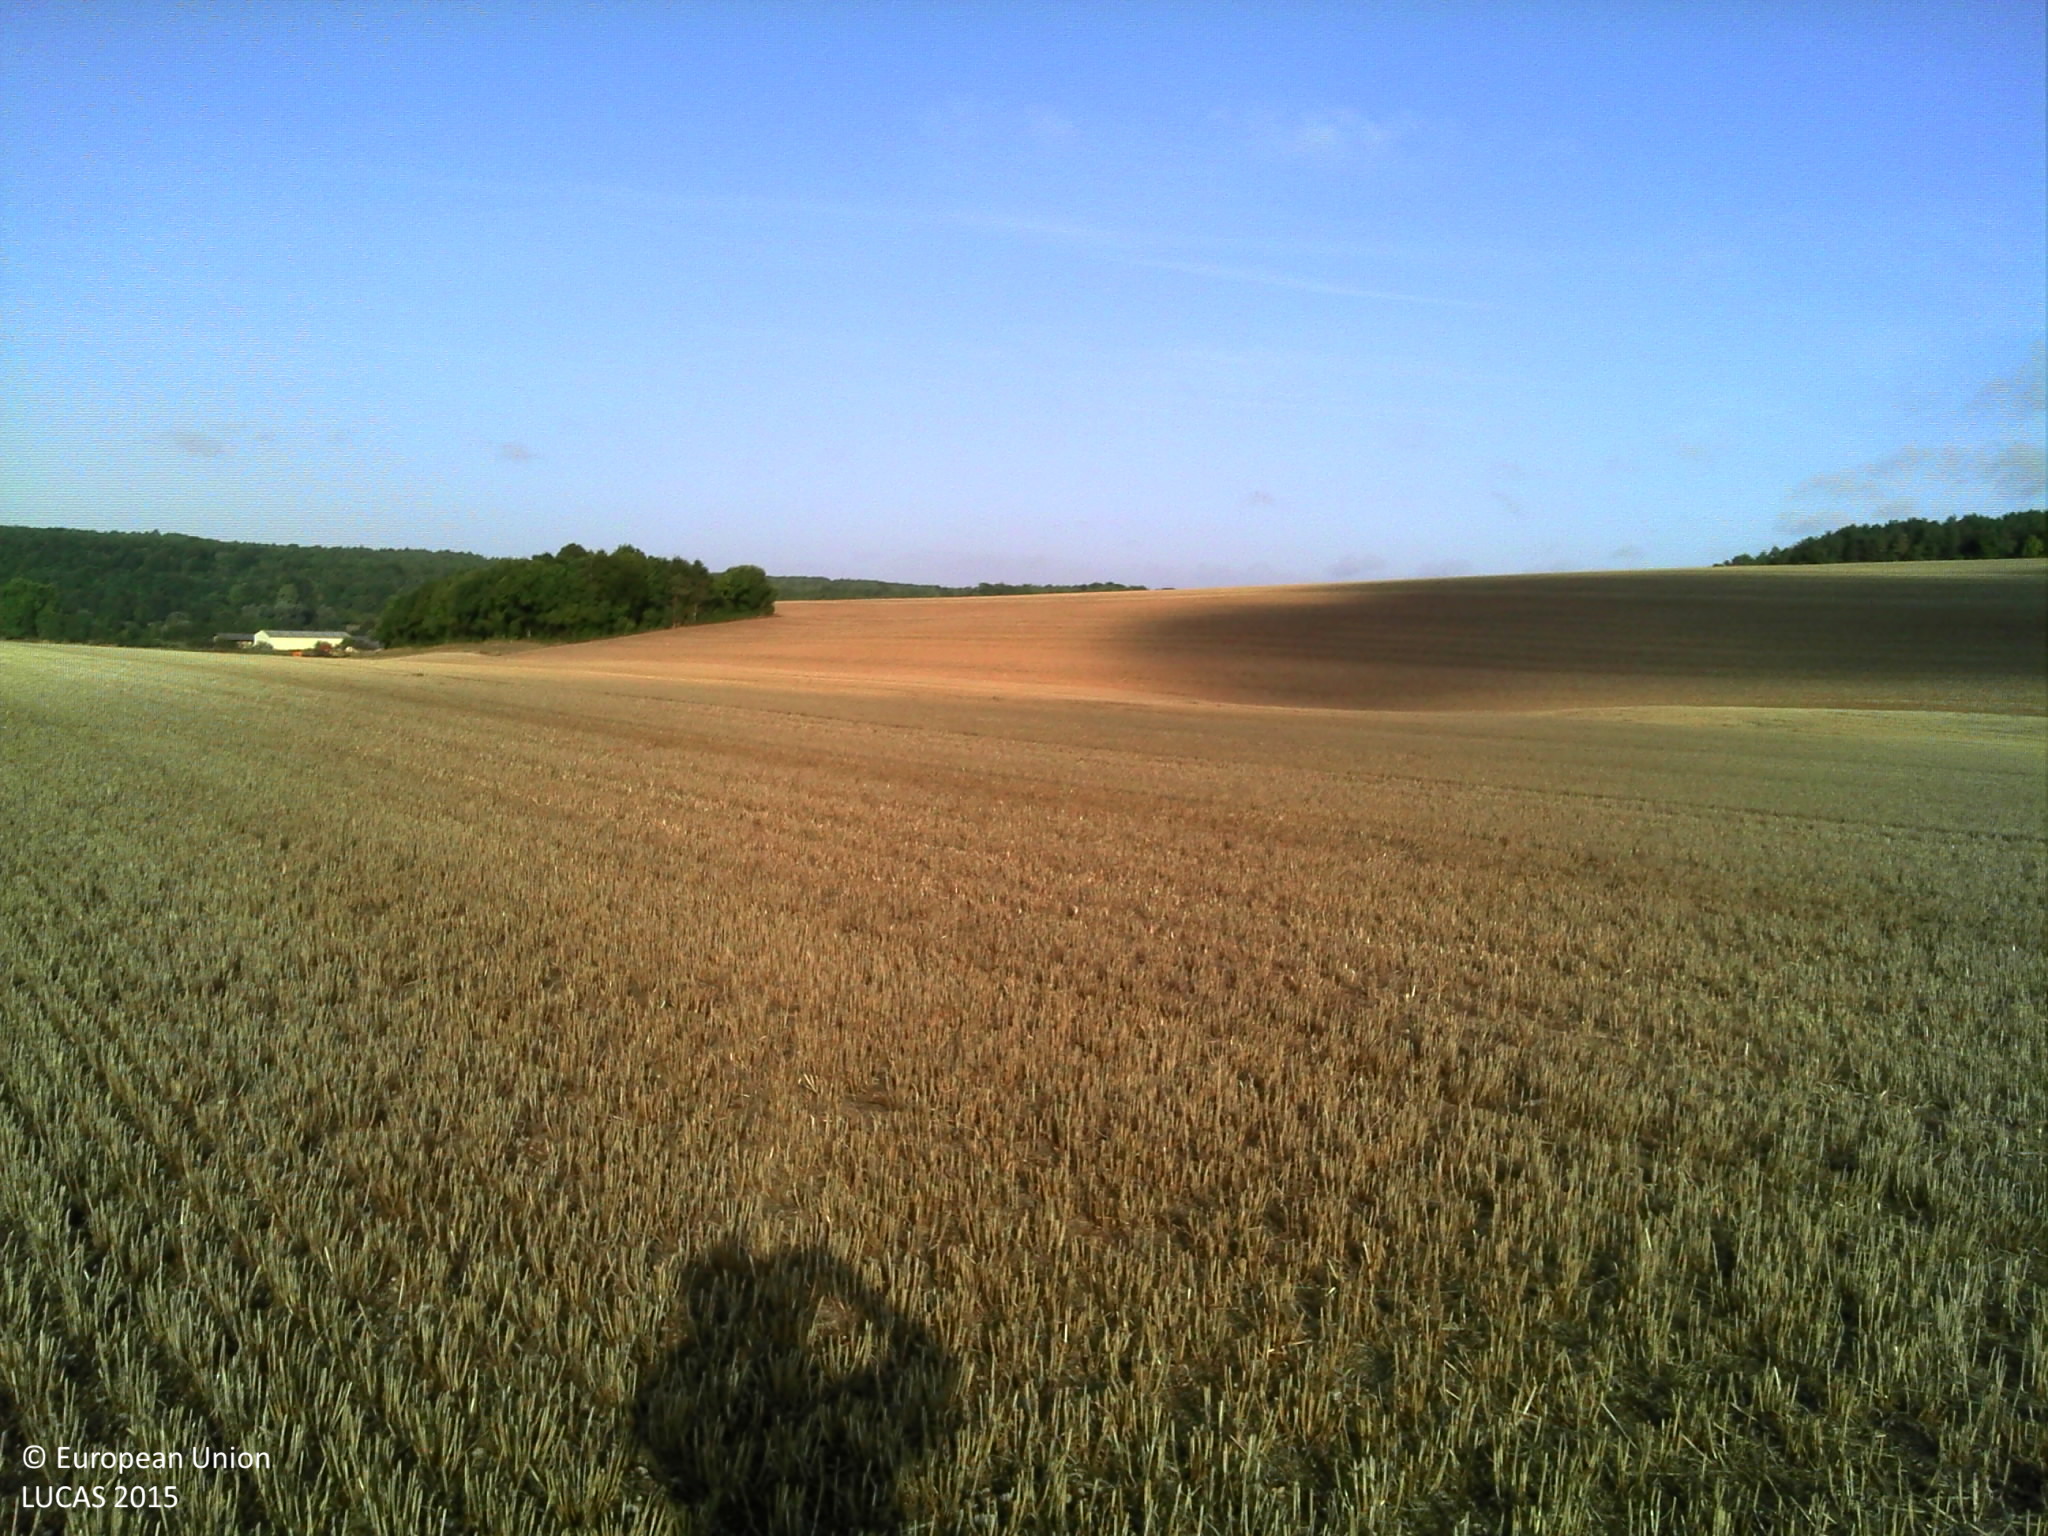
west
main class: Cropland
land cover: Common wheat
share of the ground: > 75 %
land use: Agriculture (excluding fallow land and kitchen gardens)
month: August
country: FR
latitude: 47.8613
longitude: 4.6921
